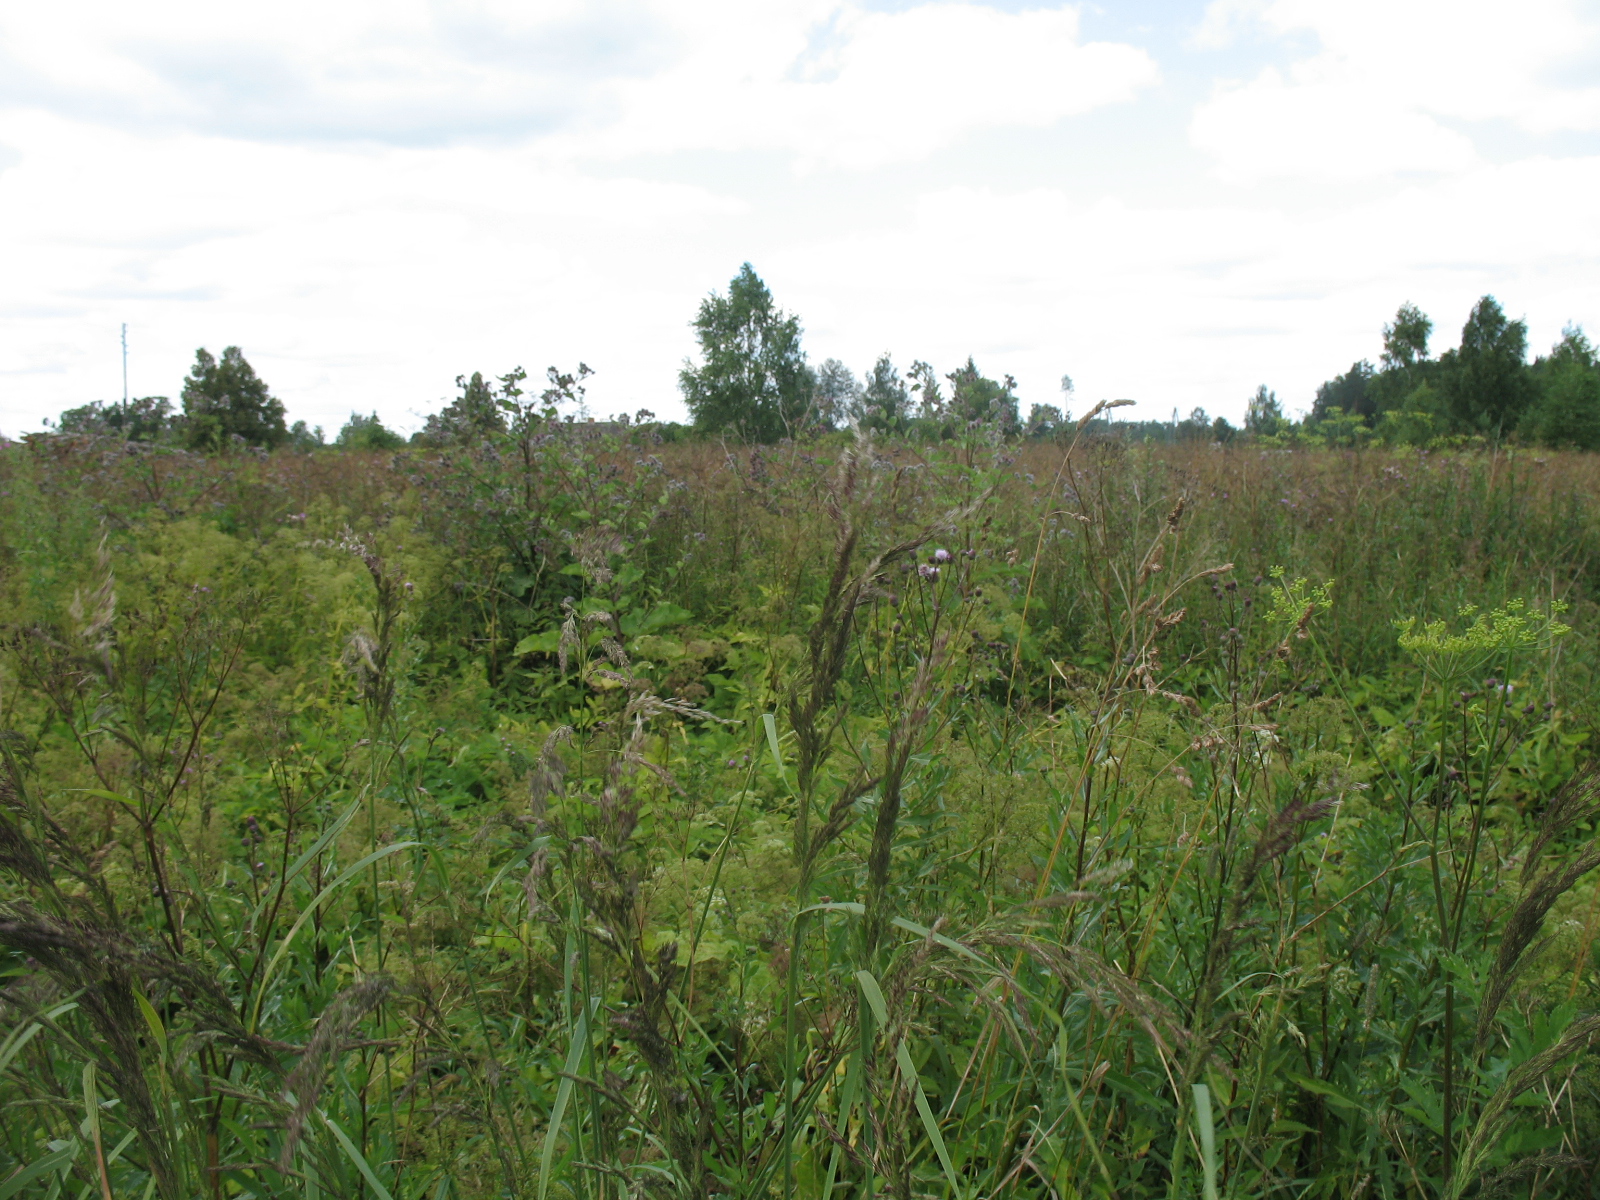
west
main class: Grassland
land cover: Spontaneously vegetated surfaces
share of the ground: > 75 %
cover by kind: herbaceous plants 100 %
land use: Semi-natural and natural areas not in use
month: July
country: LV
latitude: 56.2925
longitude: 25.1215
